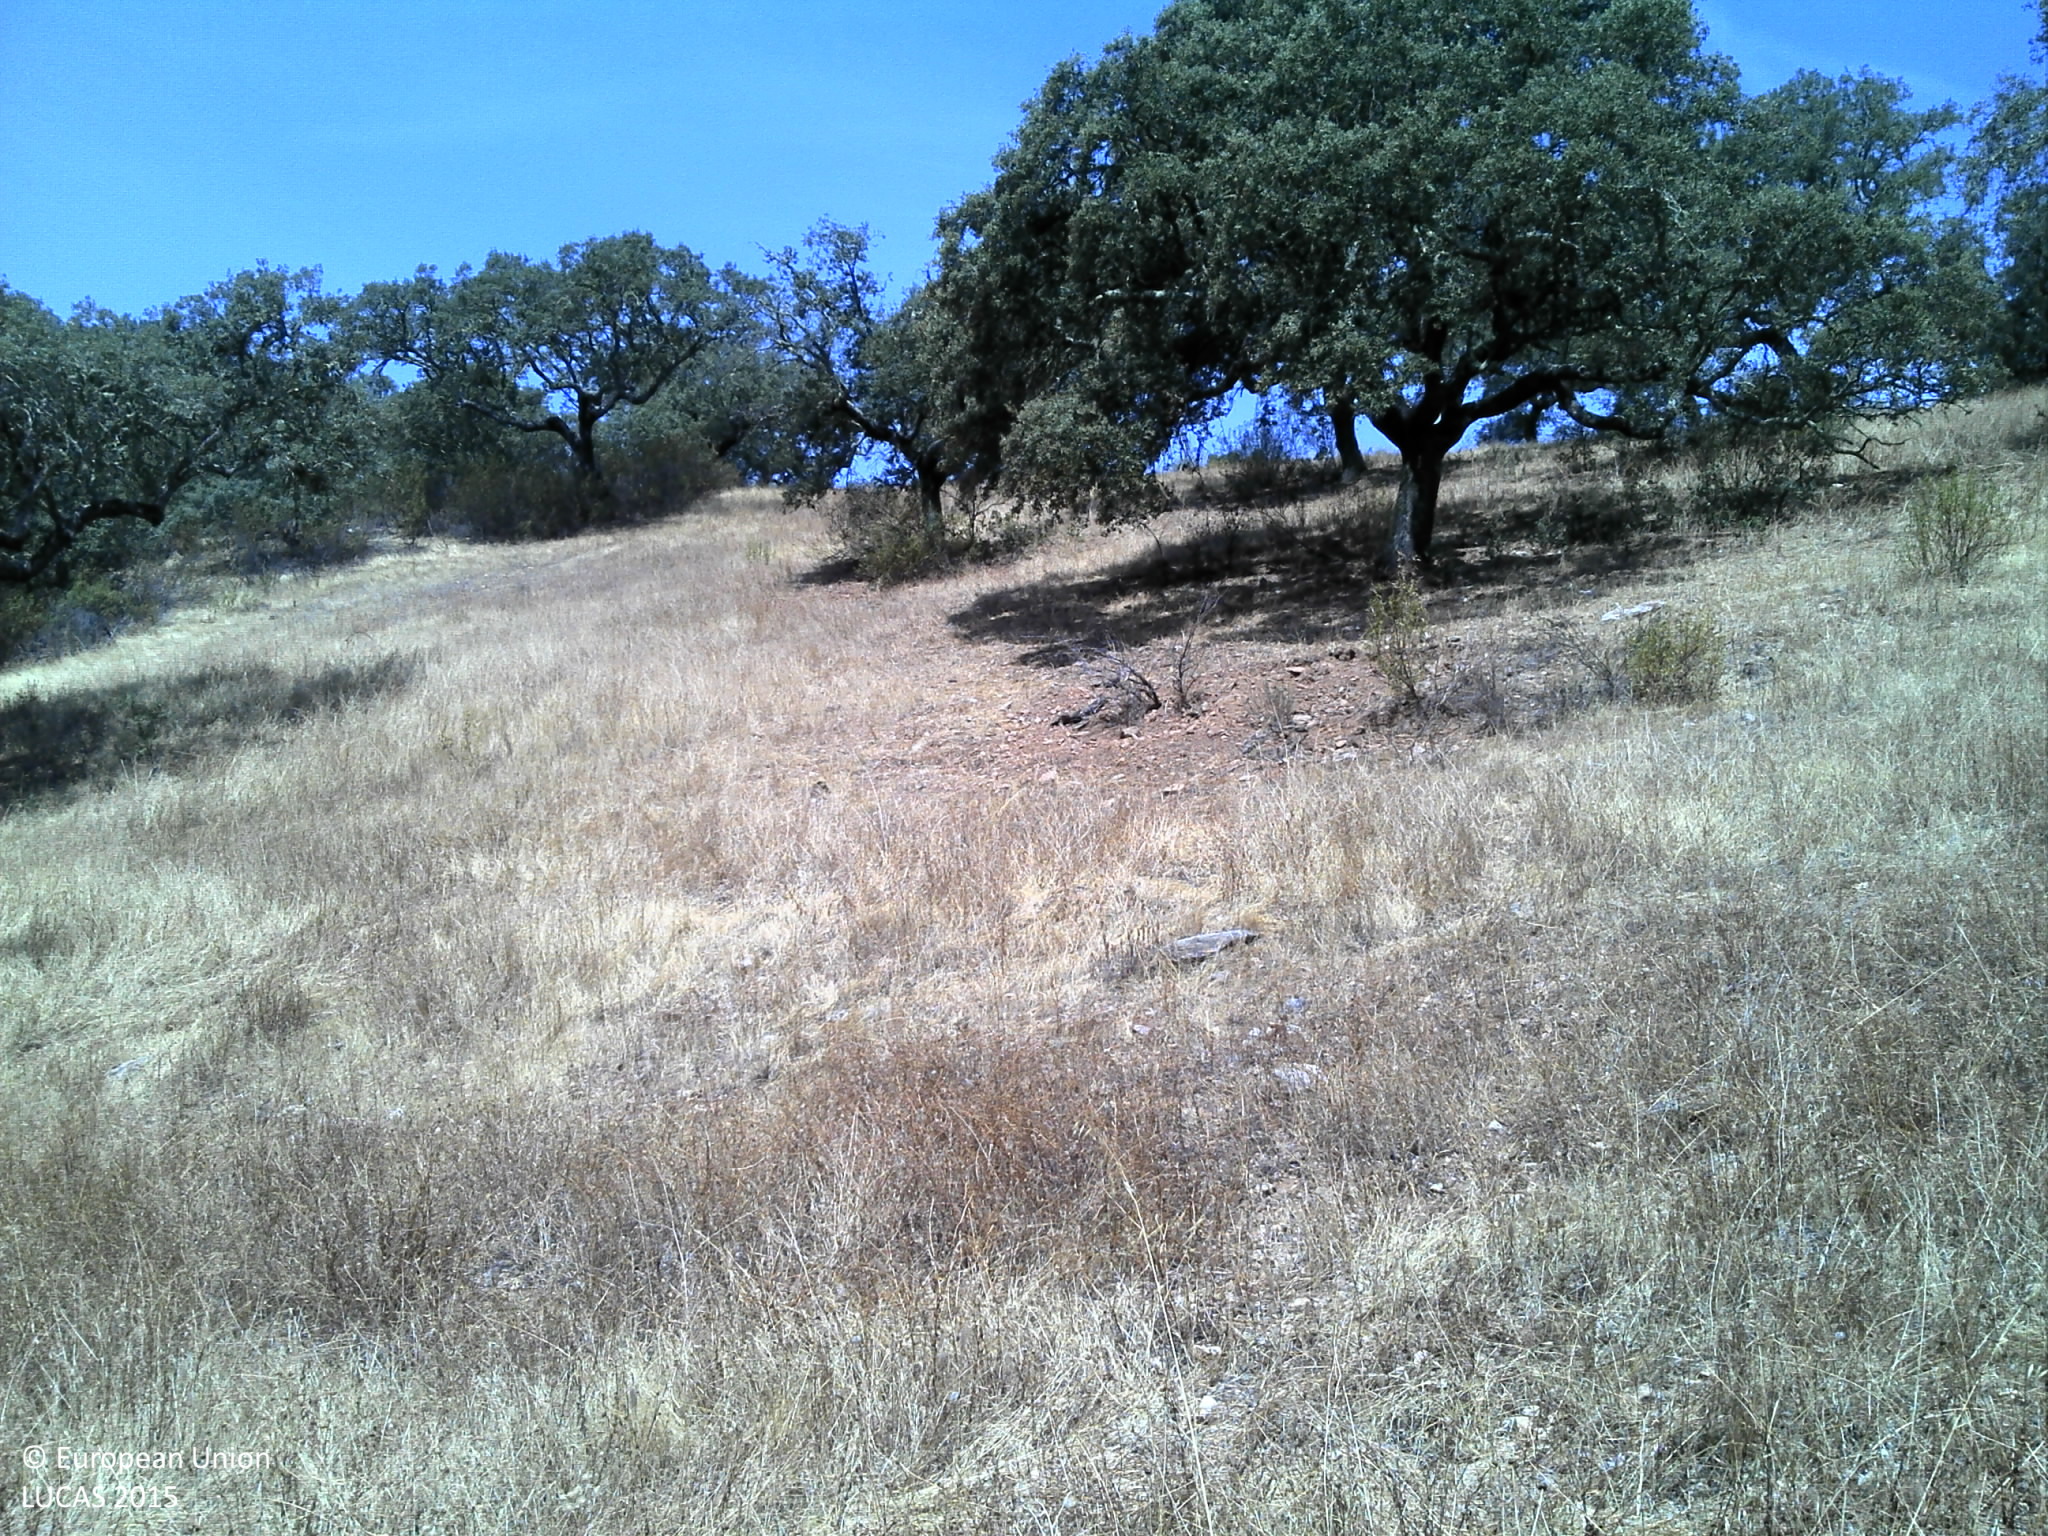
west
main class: Grassland
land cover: Grassland without tree/shrub cover
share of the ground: 25 - 50 %
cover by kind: unconsolidated bare surface 65 %, herbaceous plants 30 %, shrubs 5 %
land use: Agriculture (excluding fallow land and kitchen gardens)
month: July
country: PT
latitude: 38.5171
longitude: -7.6841
